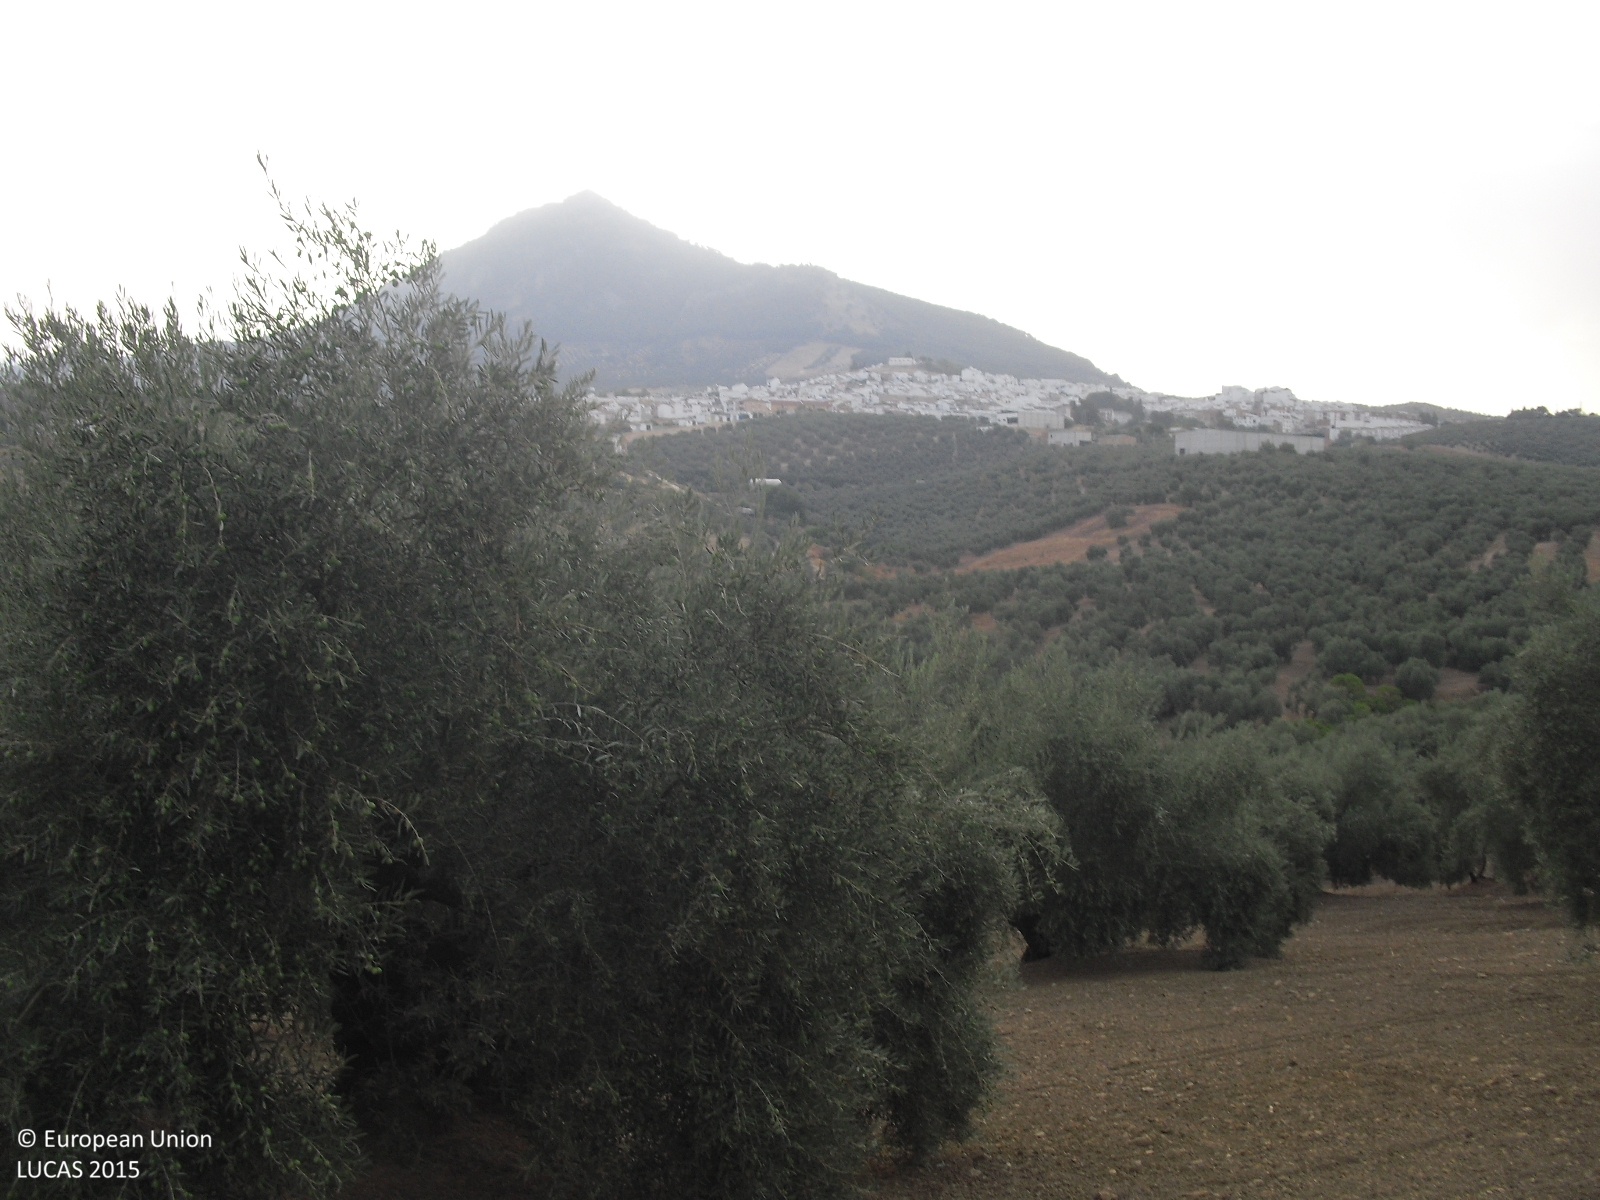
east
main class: Cropland
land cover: Olive groves
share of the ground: 25 - 50 %
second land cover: Other bare soil
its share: > 75 %
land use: Agriculture (excluding fallow land and kitchen gardens)
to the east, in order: Olive groves; Other bare soil; Shrubland without tree cover; Rivers and streams; Olive groves
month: August
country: ES
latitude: 37.3273
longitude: -4.3892
